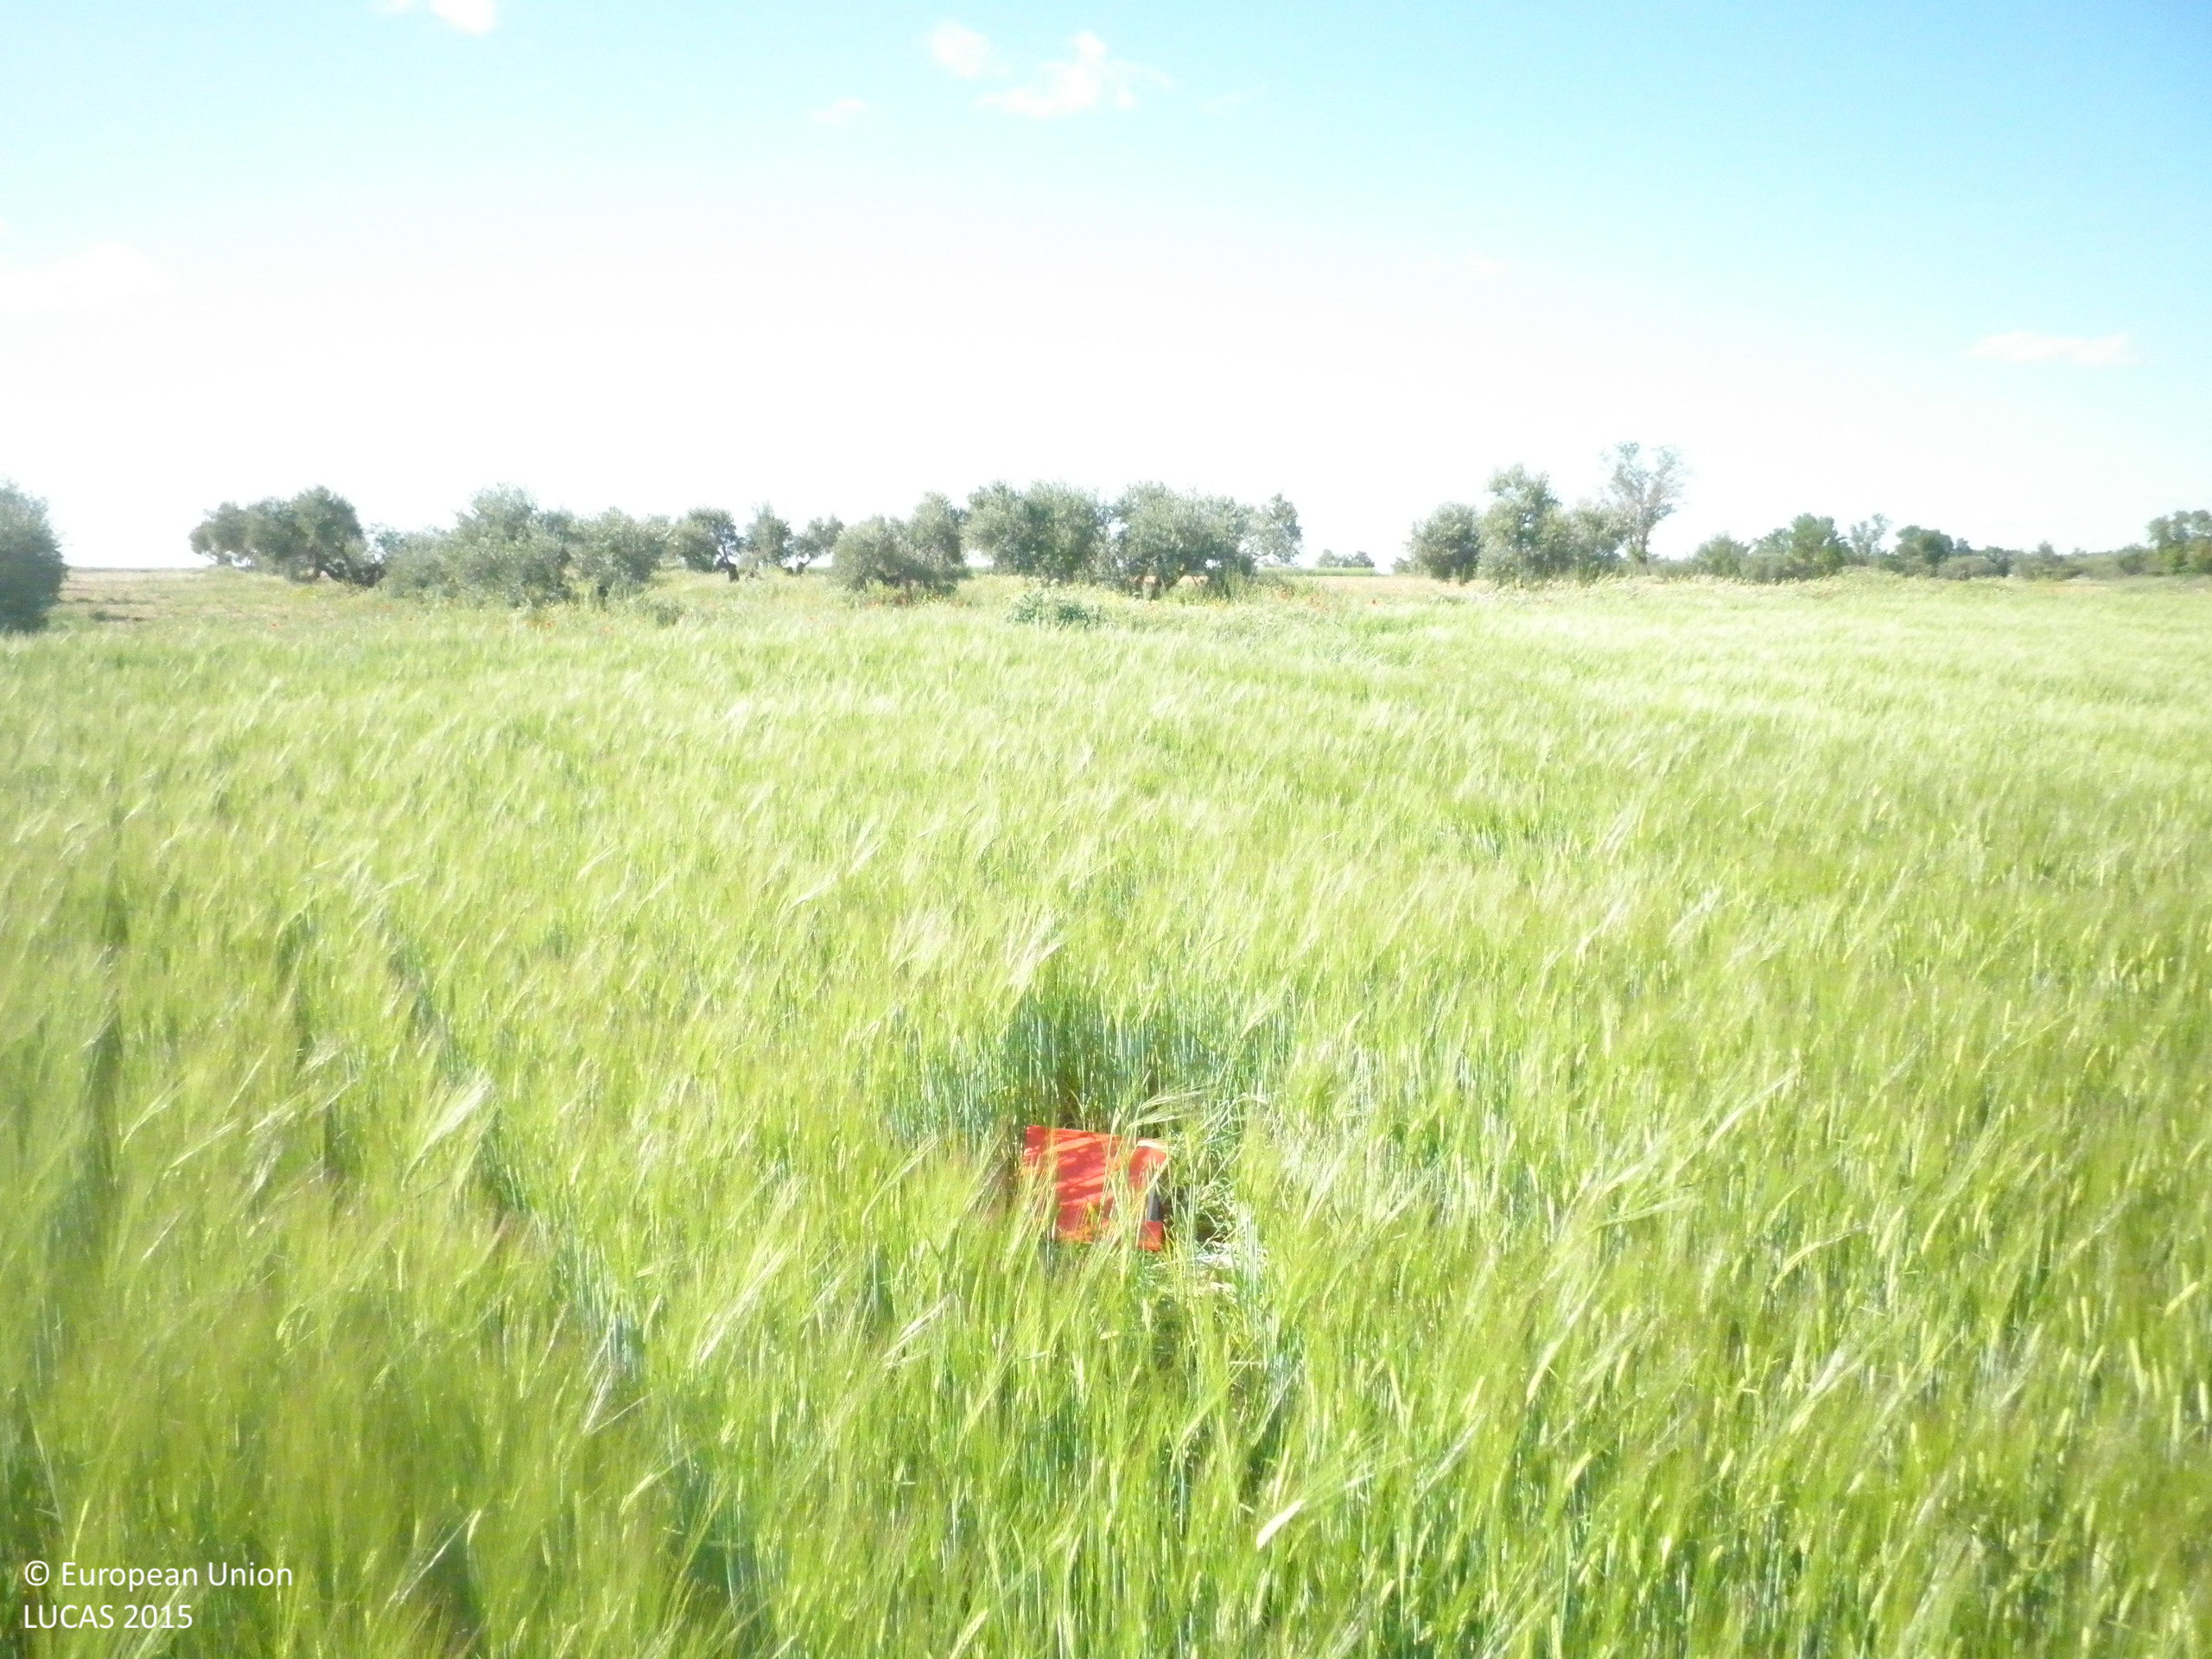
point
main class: Cropland
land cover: Barley
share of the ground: > 75 %
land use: Agriculture (excluding fallow land and kitchen gardens)
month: May
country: ES
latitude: 39.6716
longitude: -2.7351
